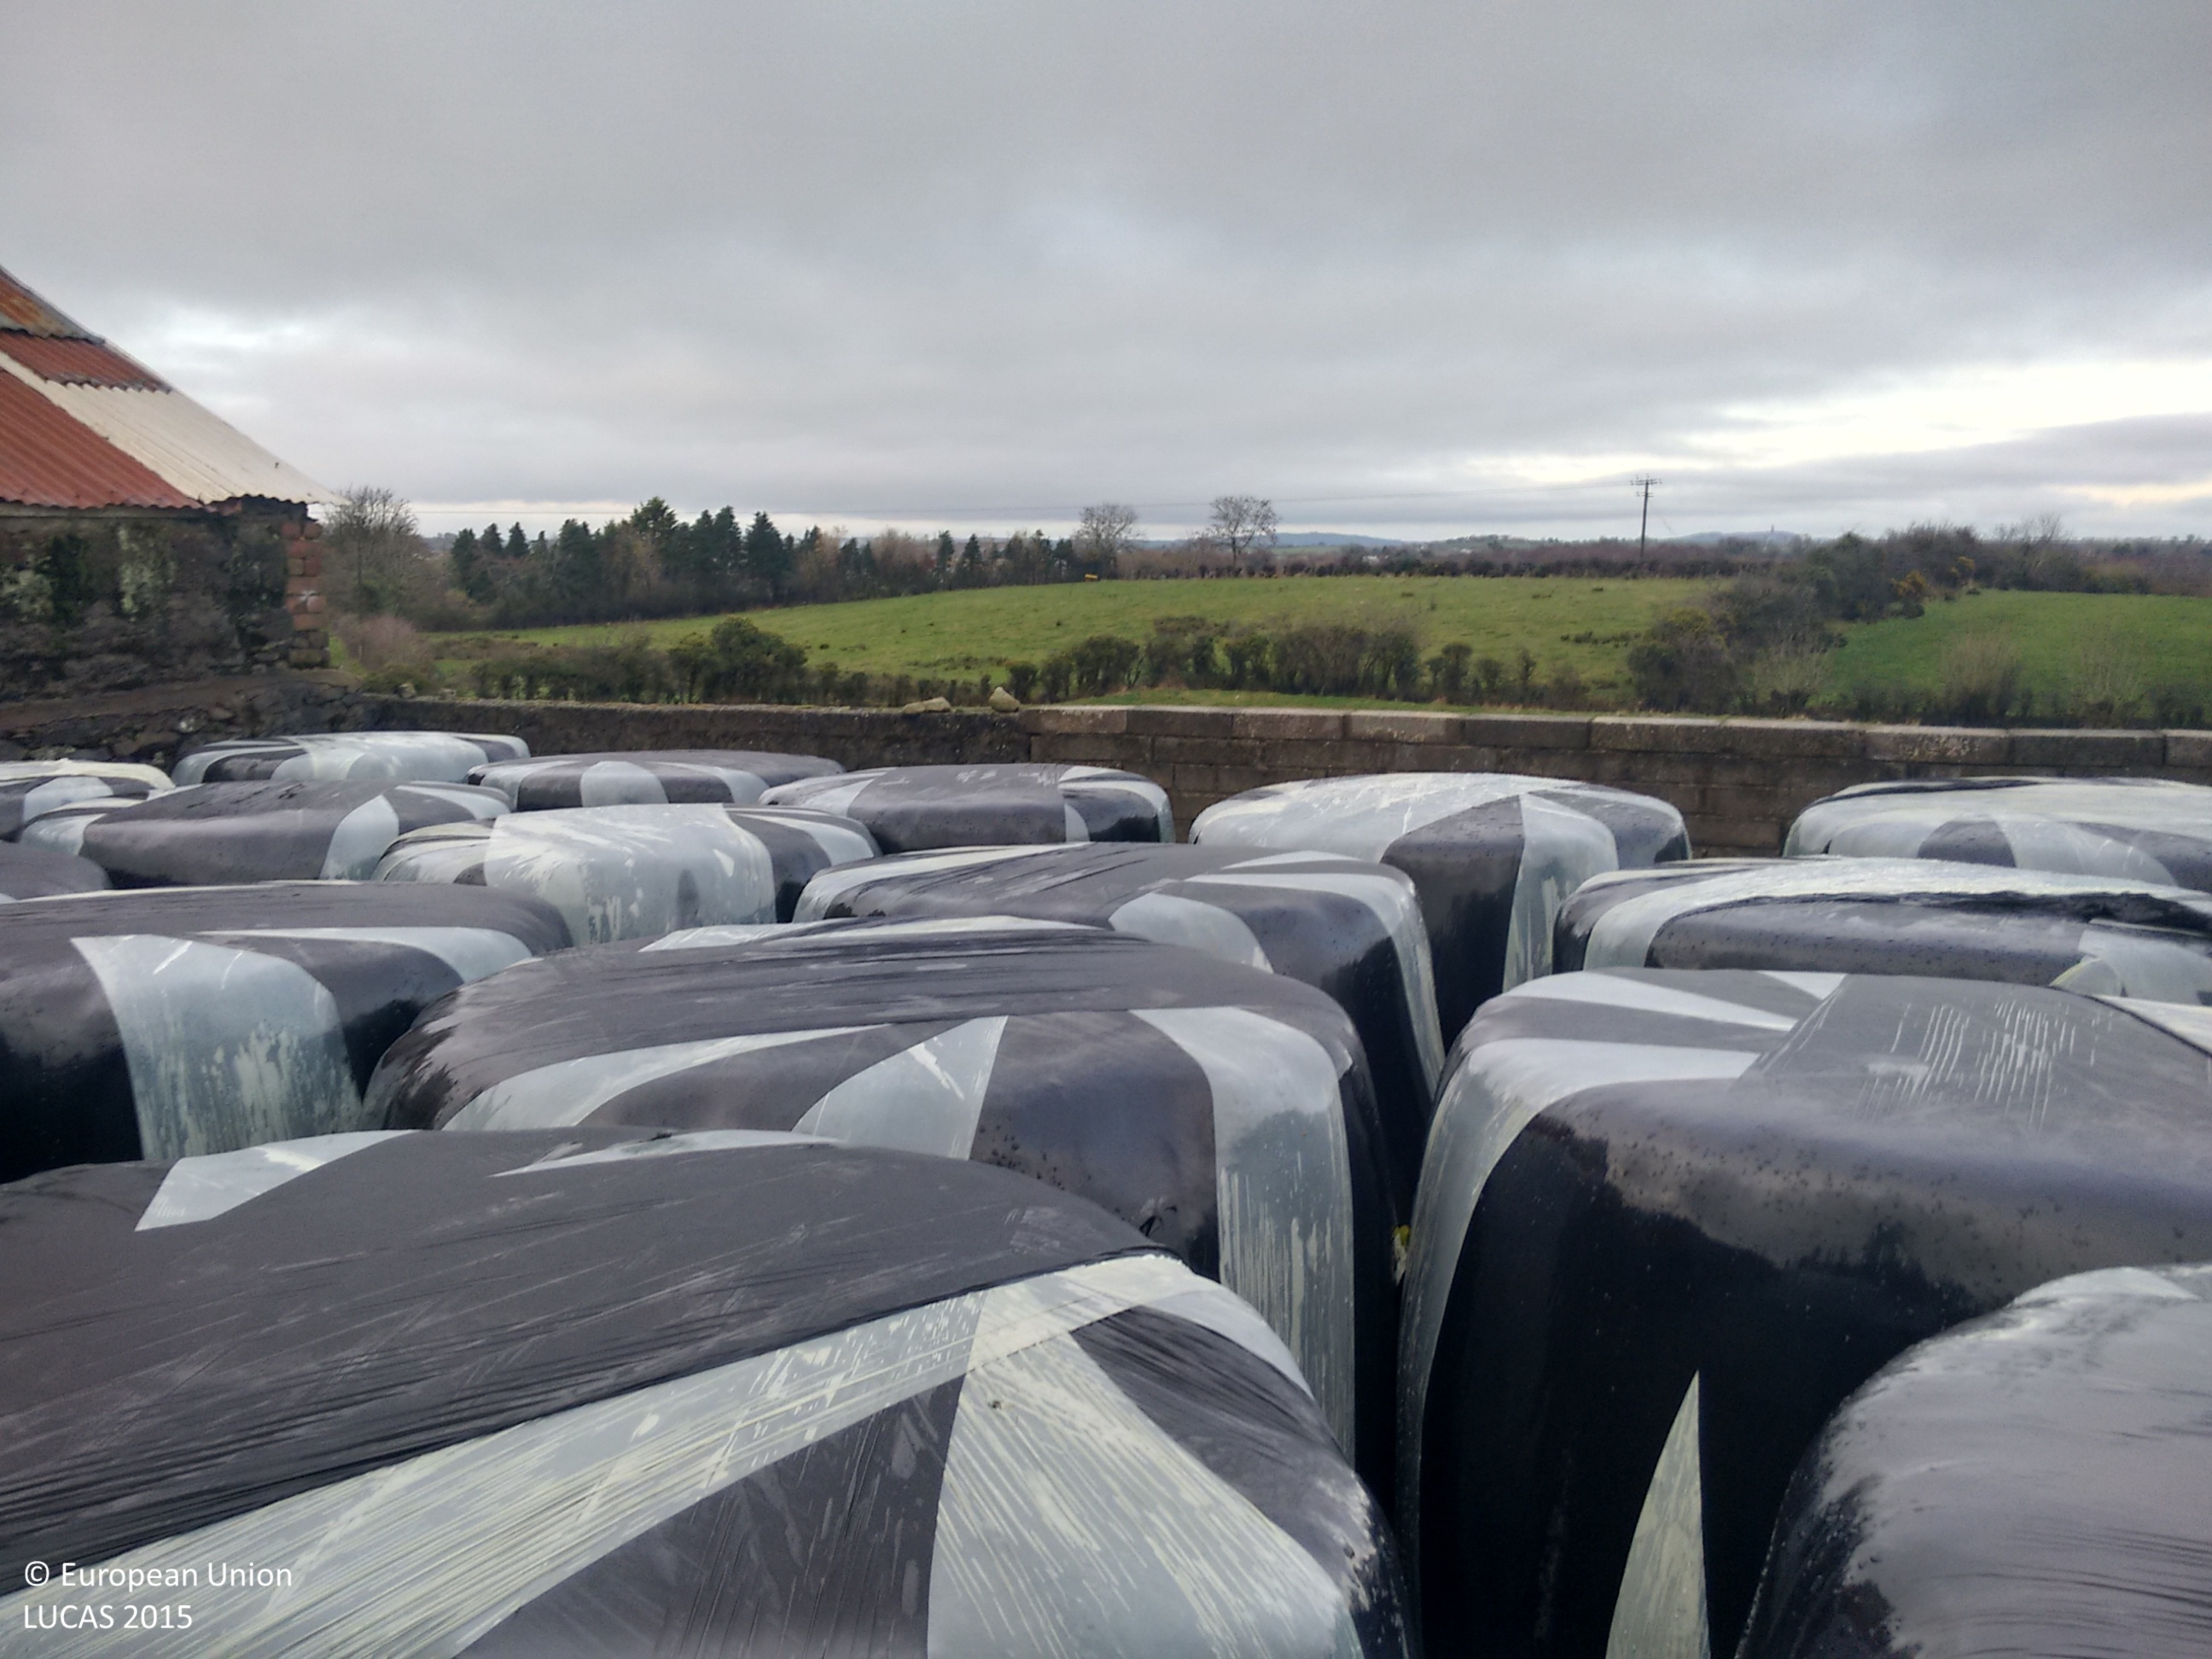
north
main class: Grassland
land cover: Grassland without tree/shrub cover
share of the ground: > 75 %
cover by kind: herbaceous plants 100 %
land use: Agriculture (excluding fallow land and kitchen gardens)
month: November
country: GB
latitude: 54.4872
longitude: -5.7718
